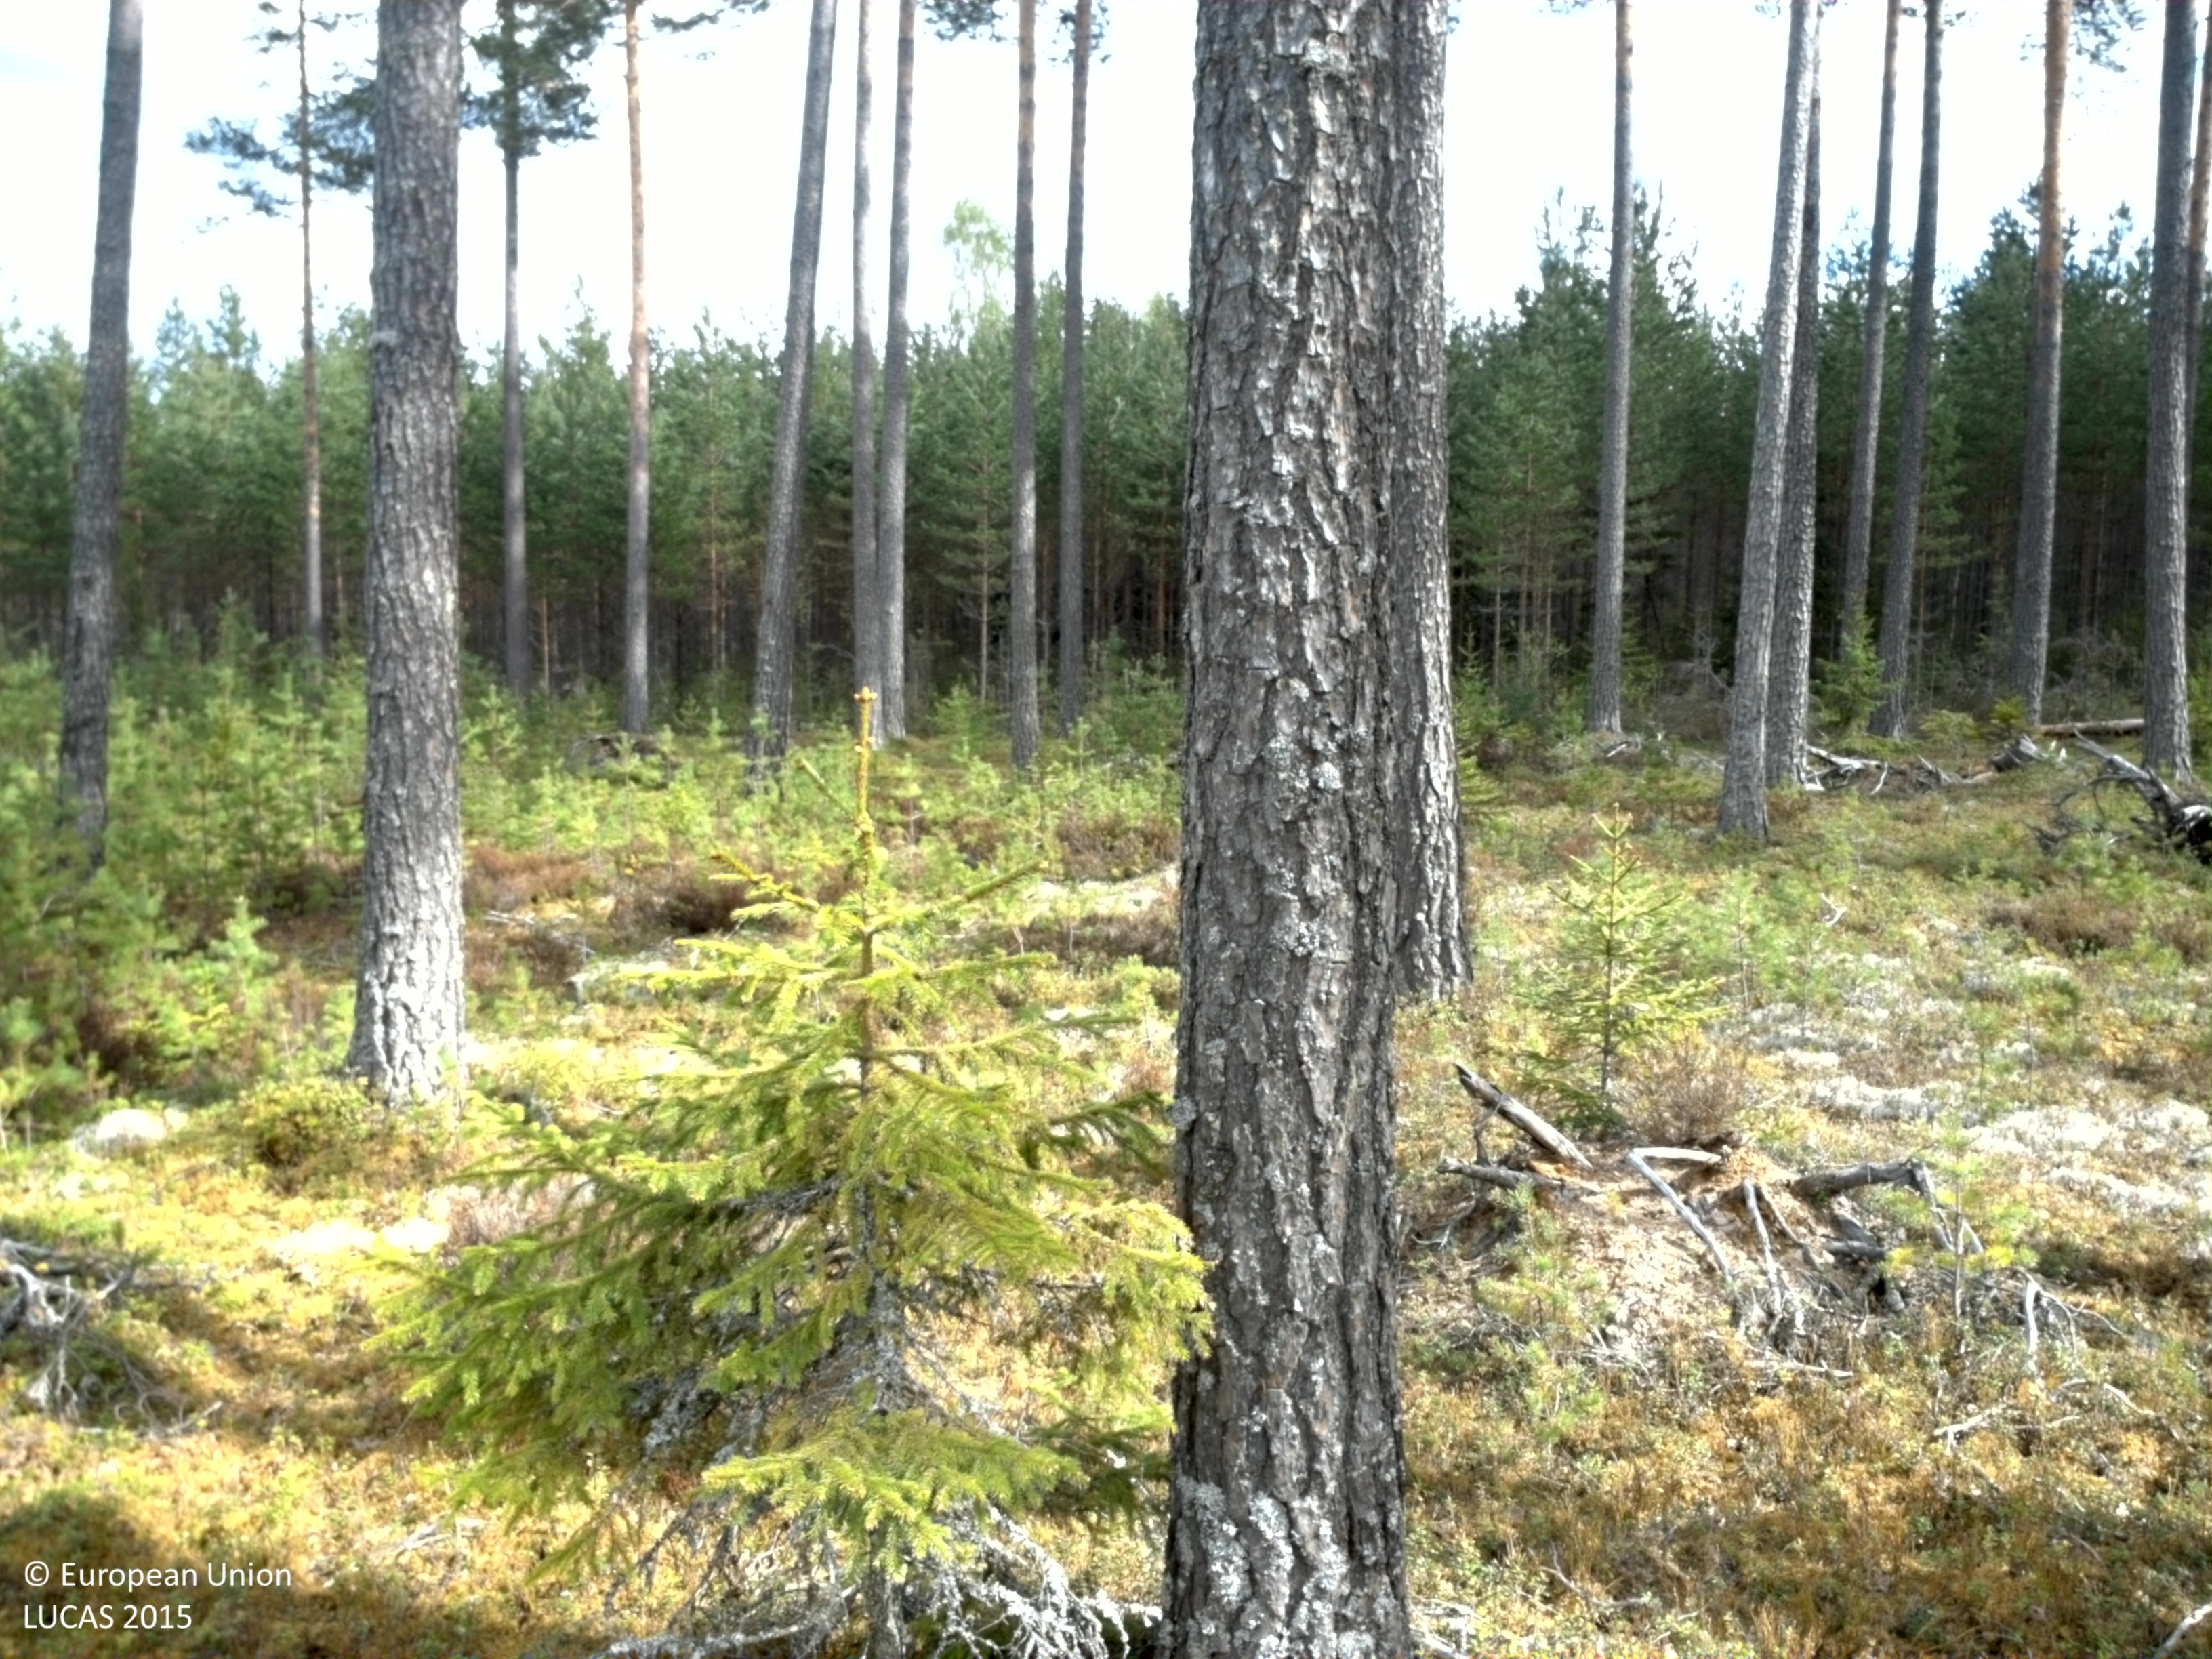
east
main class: Woodland
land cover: Pine dominated coniferous woodland
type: boreal forest
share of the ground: 25 - 50 %
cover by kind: coniferous forest trees 35 %, shrubs 25 %, herbaceous plants 20 %, lichens and mosses 20 %
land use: Forestry
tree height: > 5 m
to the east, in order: Pine dominated coniferous woodland
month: May
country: SE
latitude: 61.1727
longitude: 15.0610
